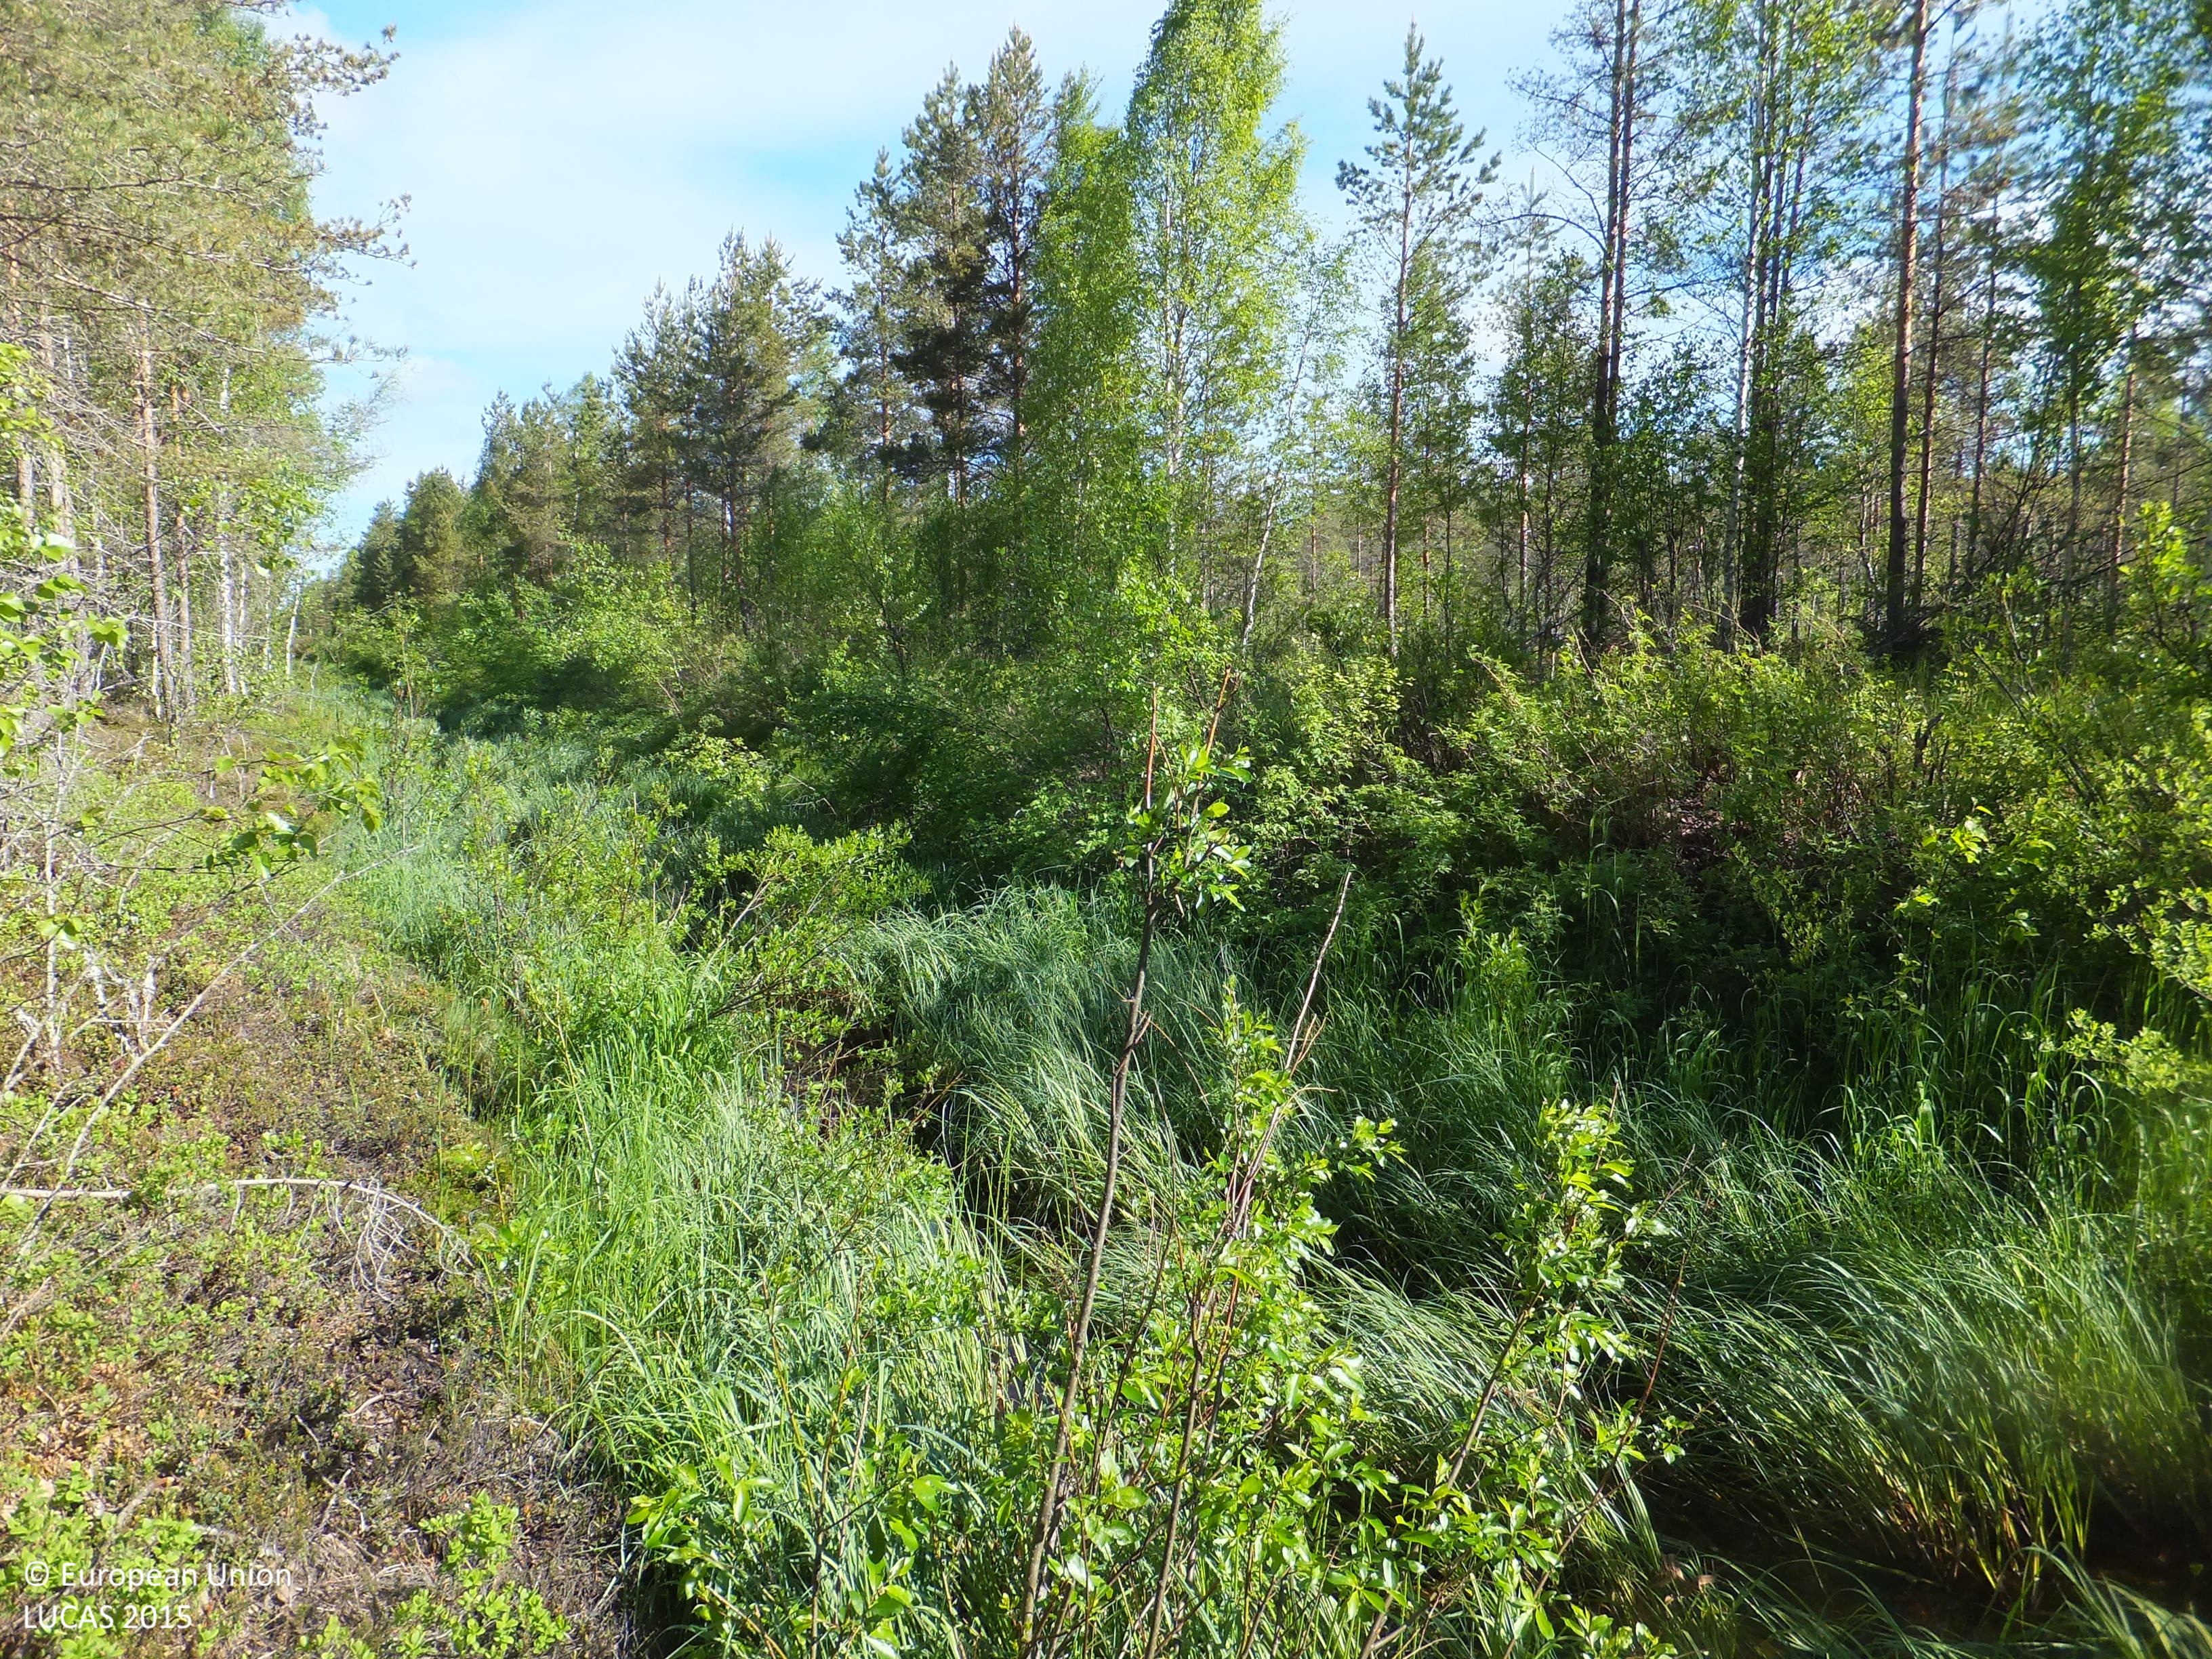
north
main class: Woodland
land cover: Broadleaved woodland
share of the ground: > 75 %
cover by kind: broadleaved forest trees 80 %, shrubs 15 %, coniferous forest trees 5 %
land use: Forestry
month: June
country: FI
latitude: 63.4180
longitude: 22.8116
